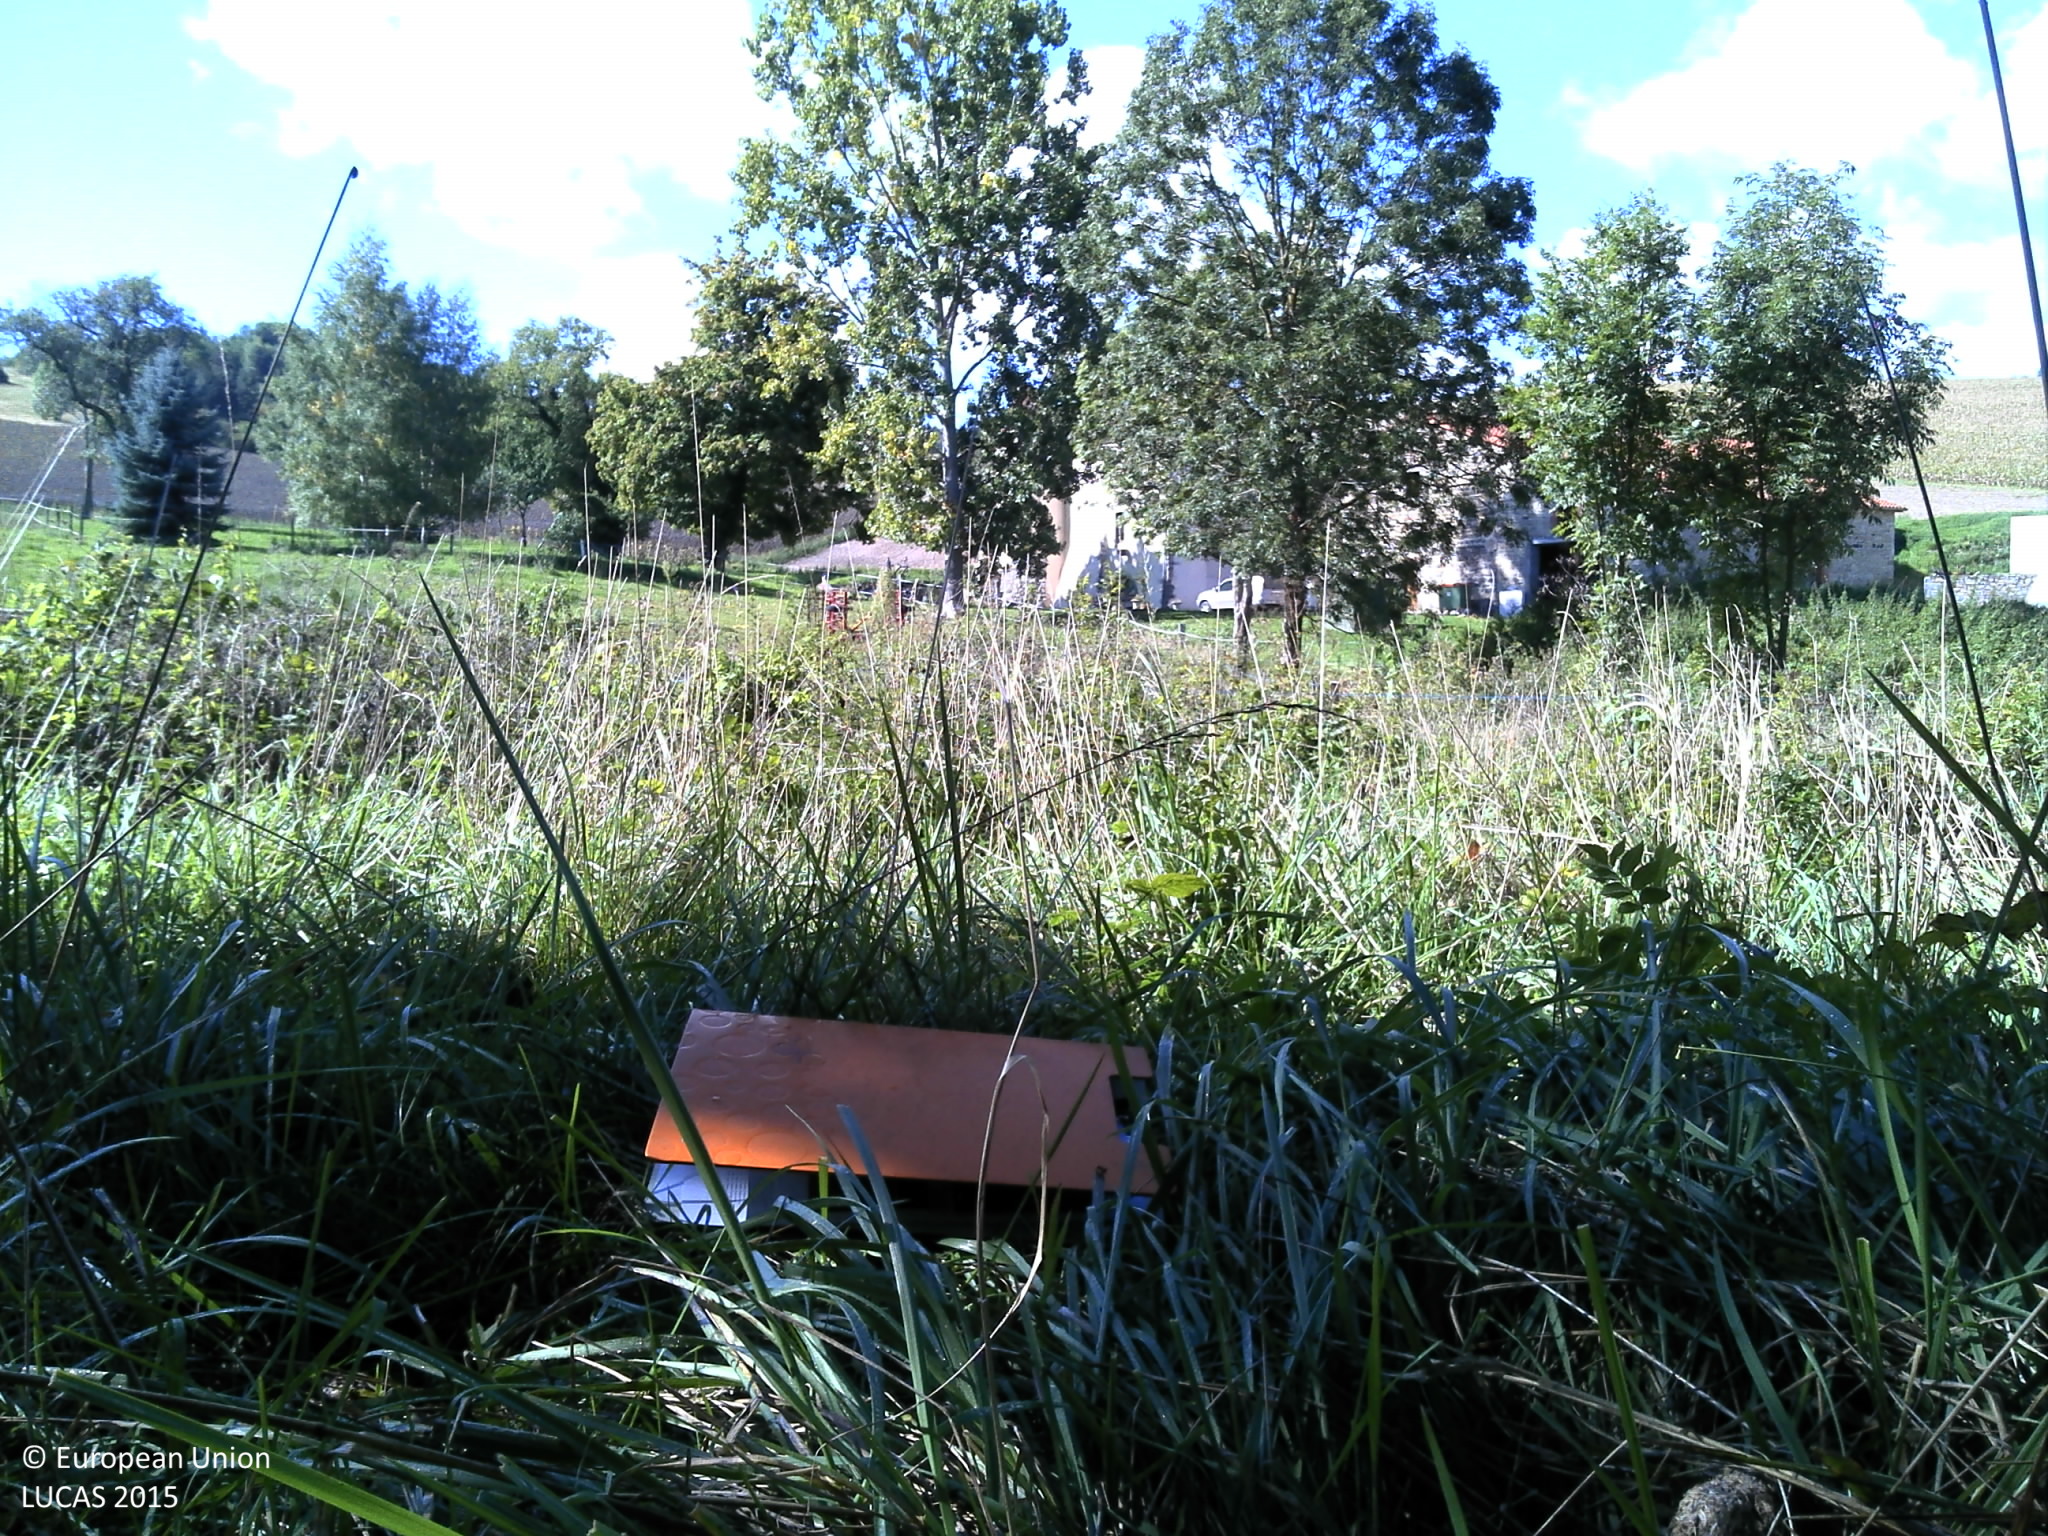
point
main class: Grassland
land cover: Grassland without tree/shrub cover
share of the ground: > 75 %
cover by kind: herbaceous plants 95 %, shrubs 5 %
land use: Agriculture (excluding fallow land and kitchen gardens)
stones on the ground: < 10 %
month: September
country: FR
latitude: 45.5675
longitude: 3.0942
